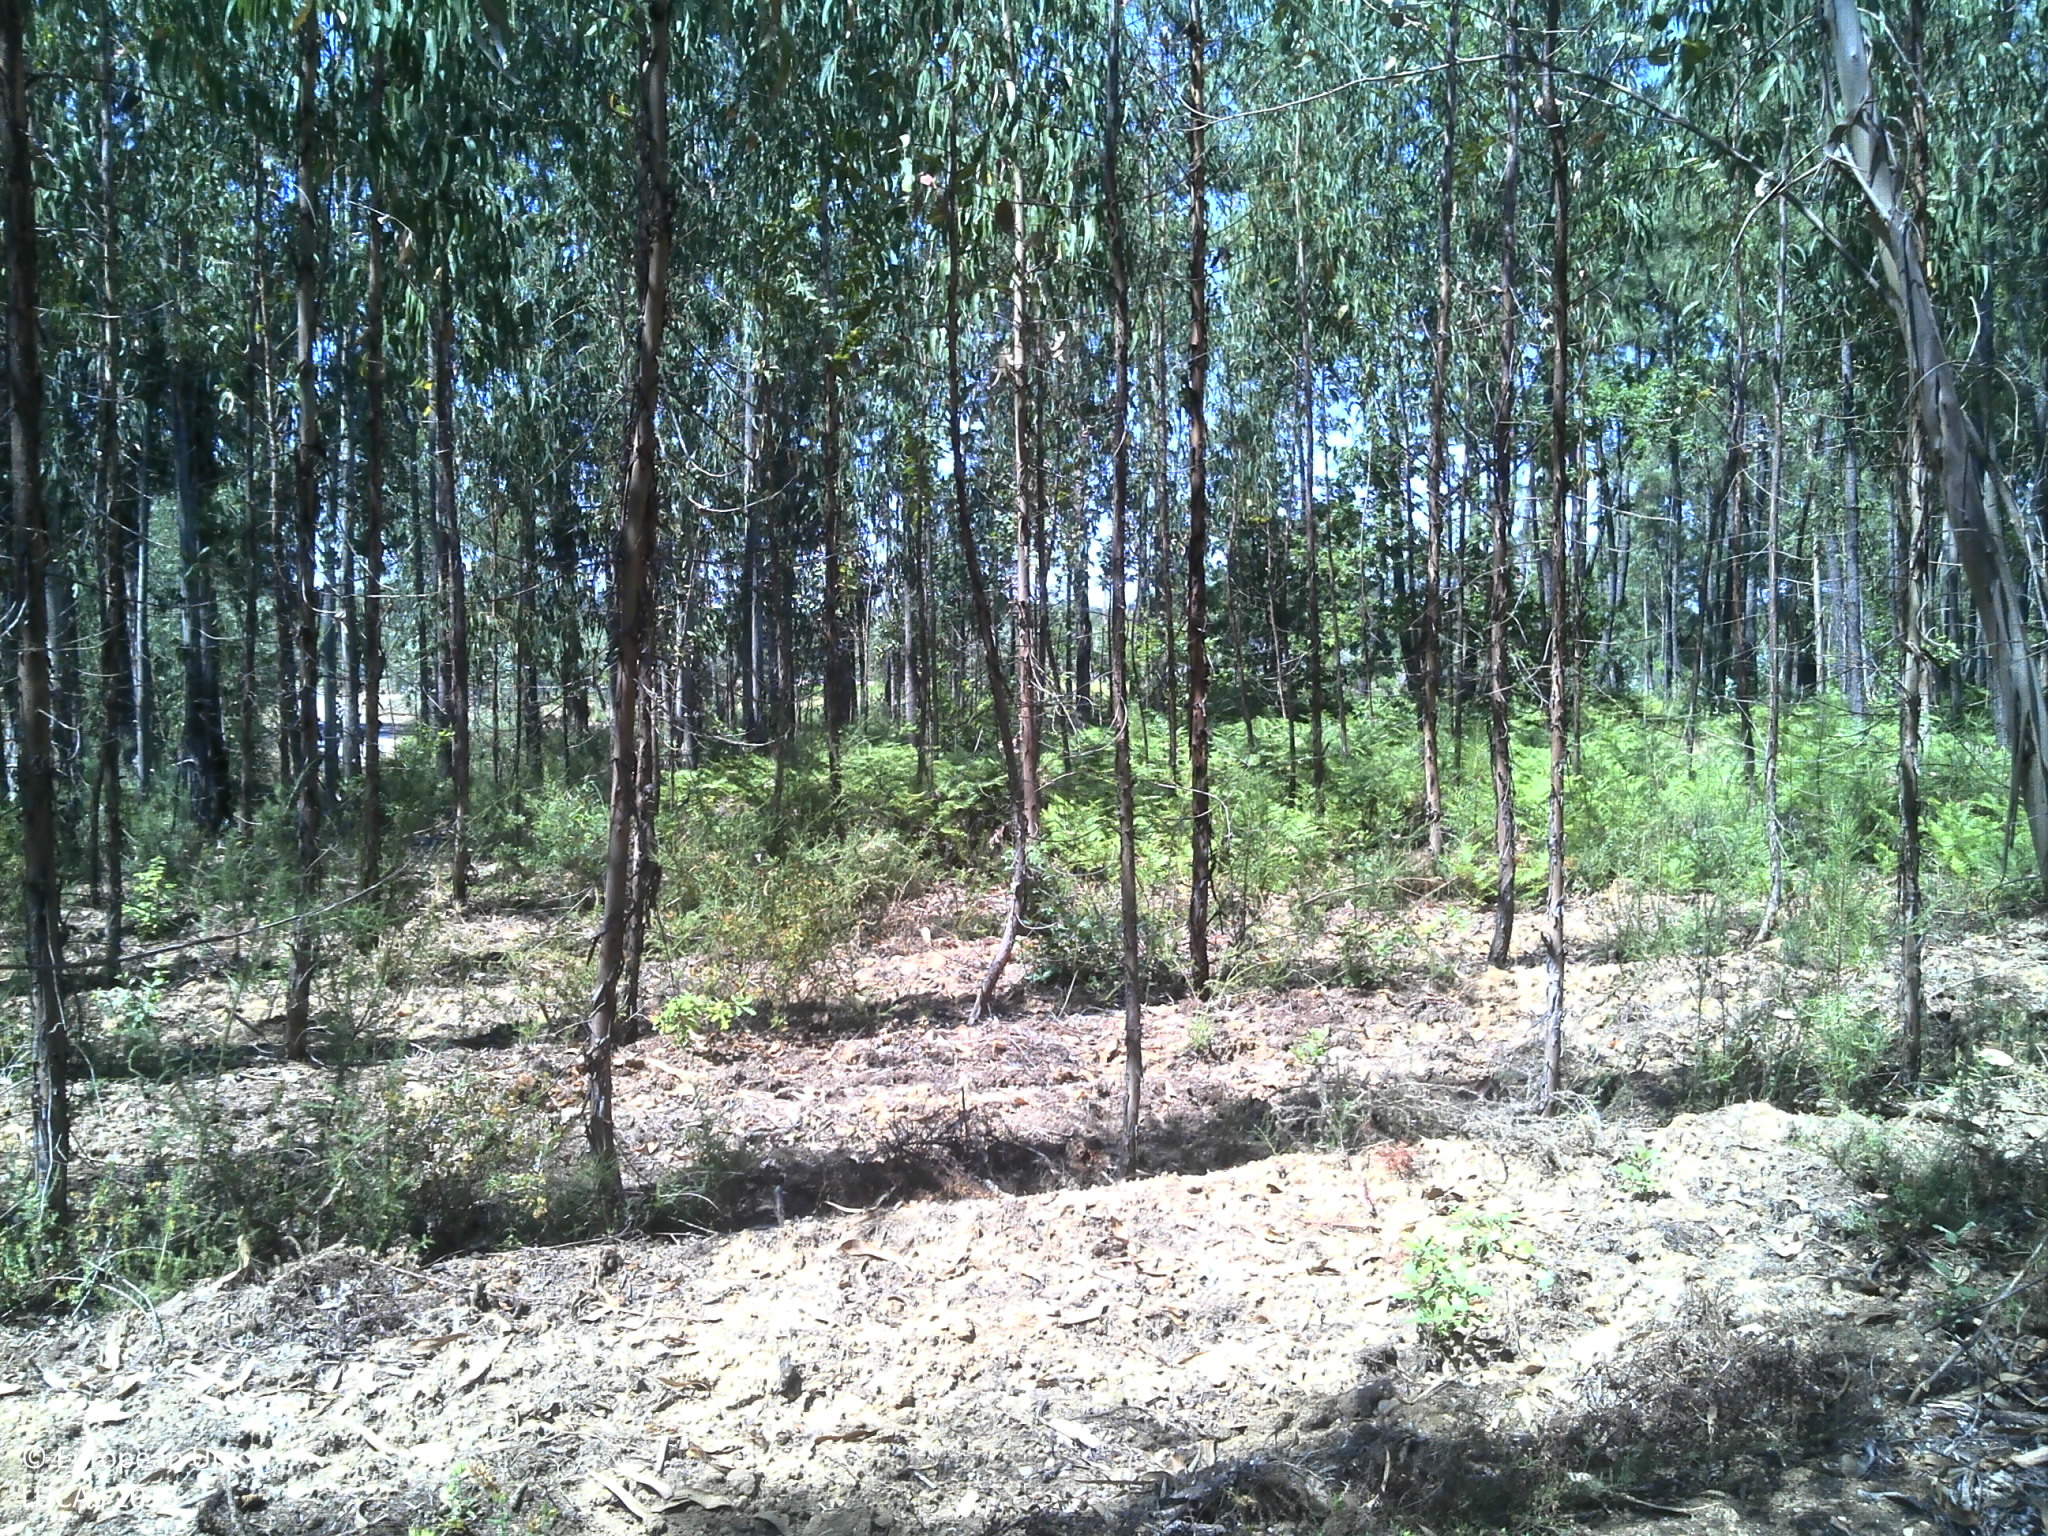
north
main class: Woodland
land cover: Broadleaved woodland
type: exotic forest
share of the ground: 25 - 50 %
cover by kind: broadleaved forest trees 50 %, unconsolidated bare surface 35 %, shrubs 15 %
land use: Forestry
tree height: > 5 m
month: July
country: PT
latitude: 40.3067
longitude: -7.9931
